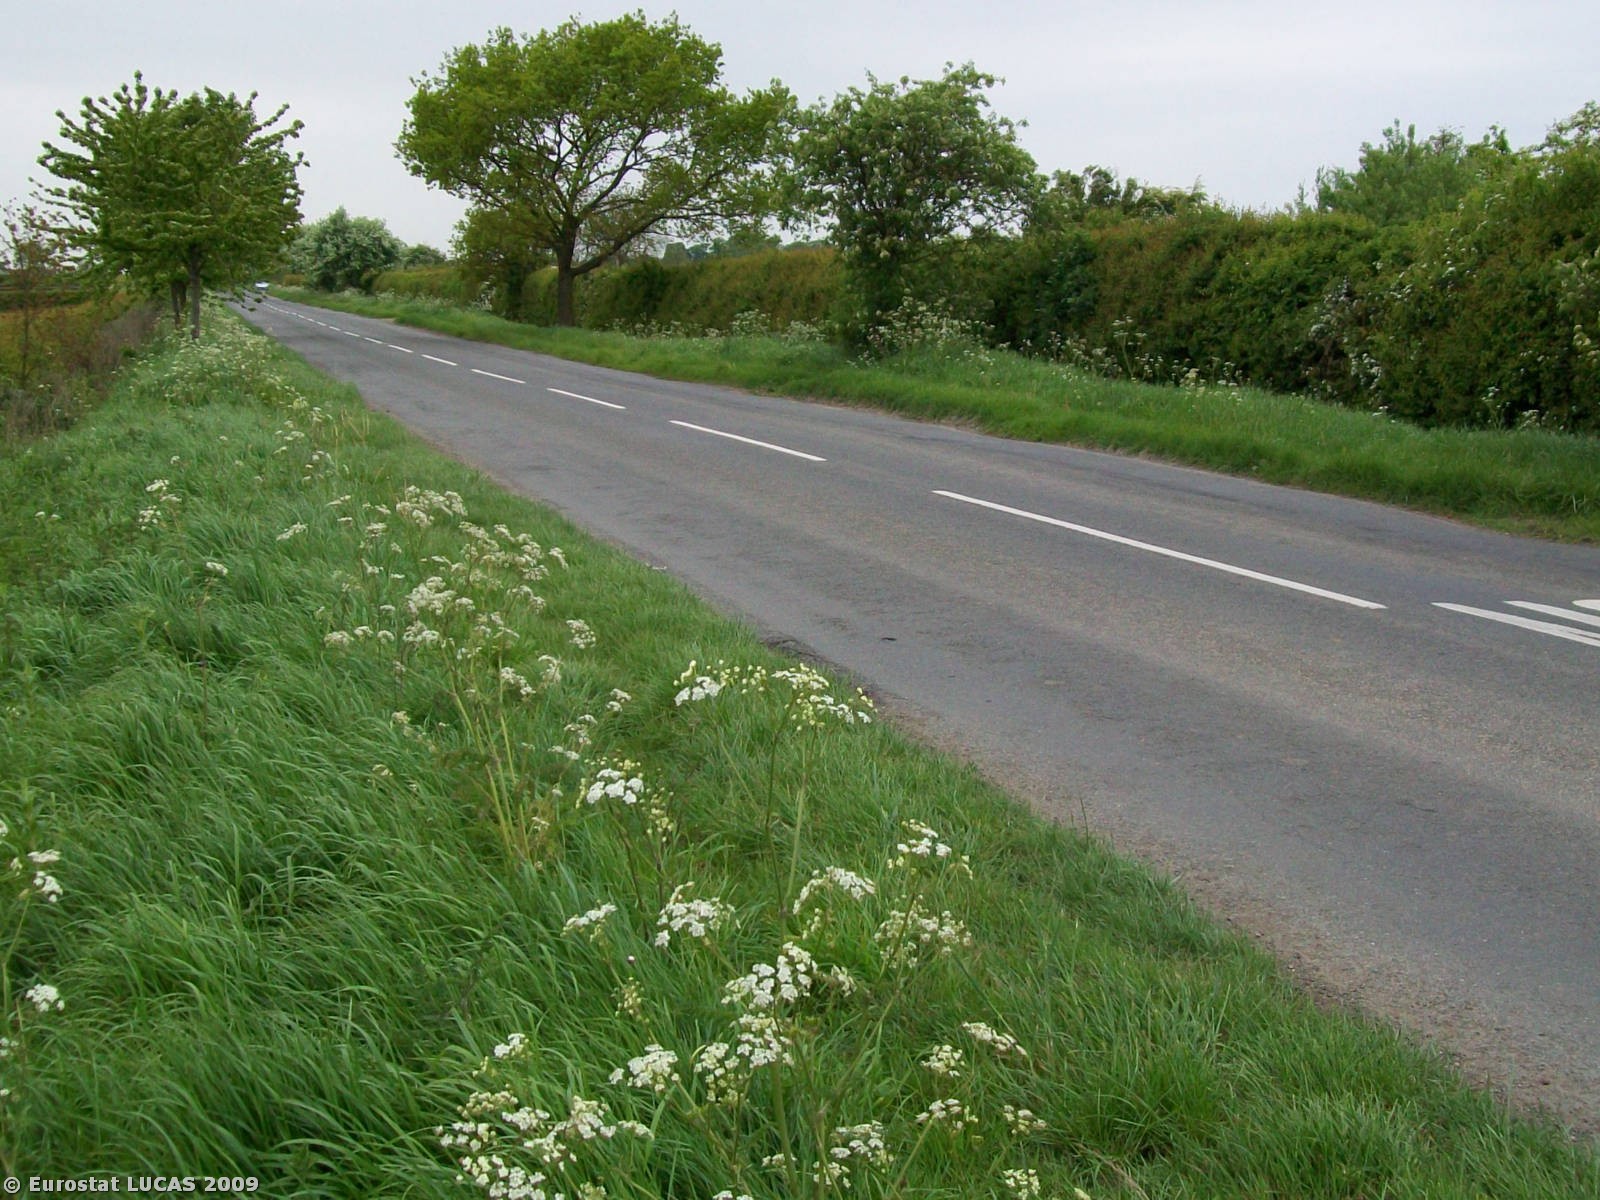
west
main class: Grassland
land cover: Grassland without tree/shrub cover
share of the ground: > 75 %
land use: Unused
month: May
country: GB
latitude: 52.8744
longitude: -0.8735
